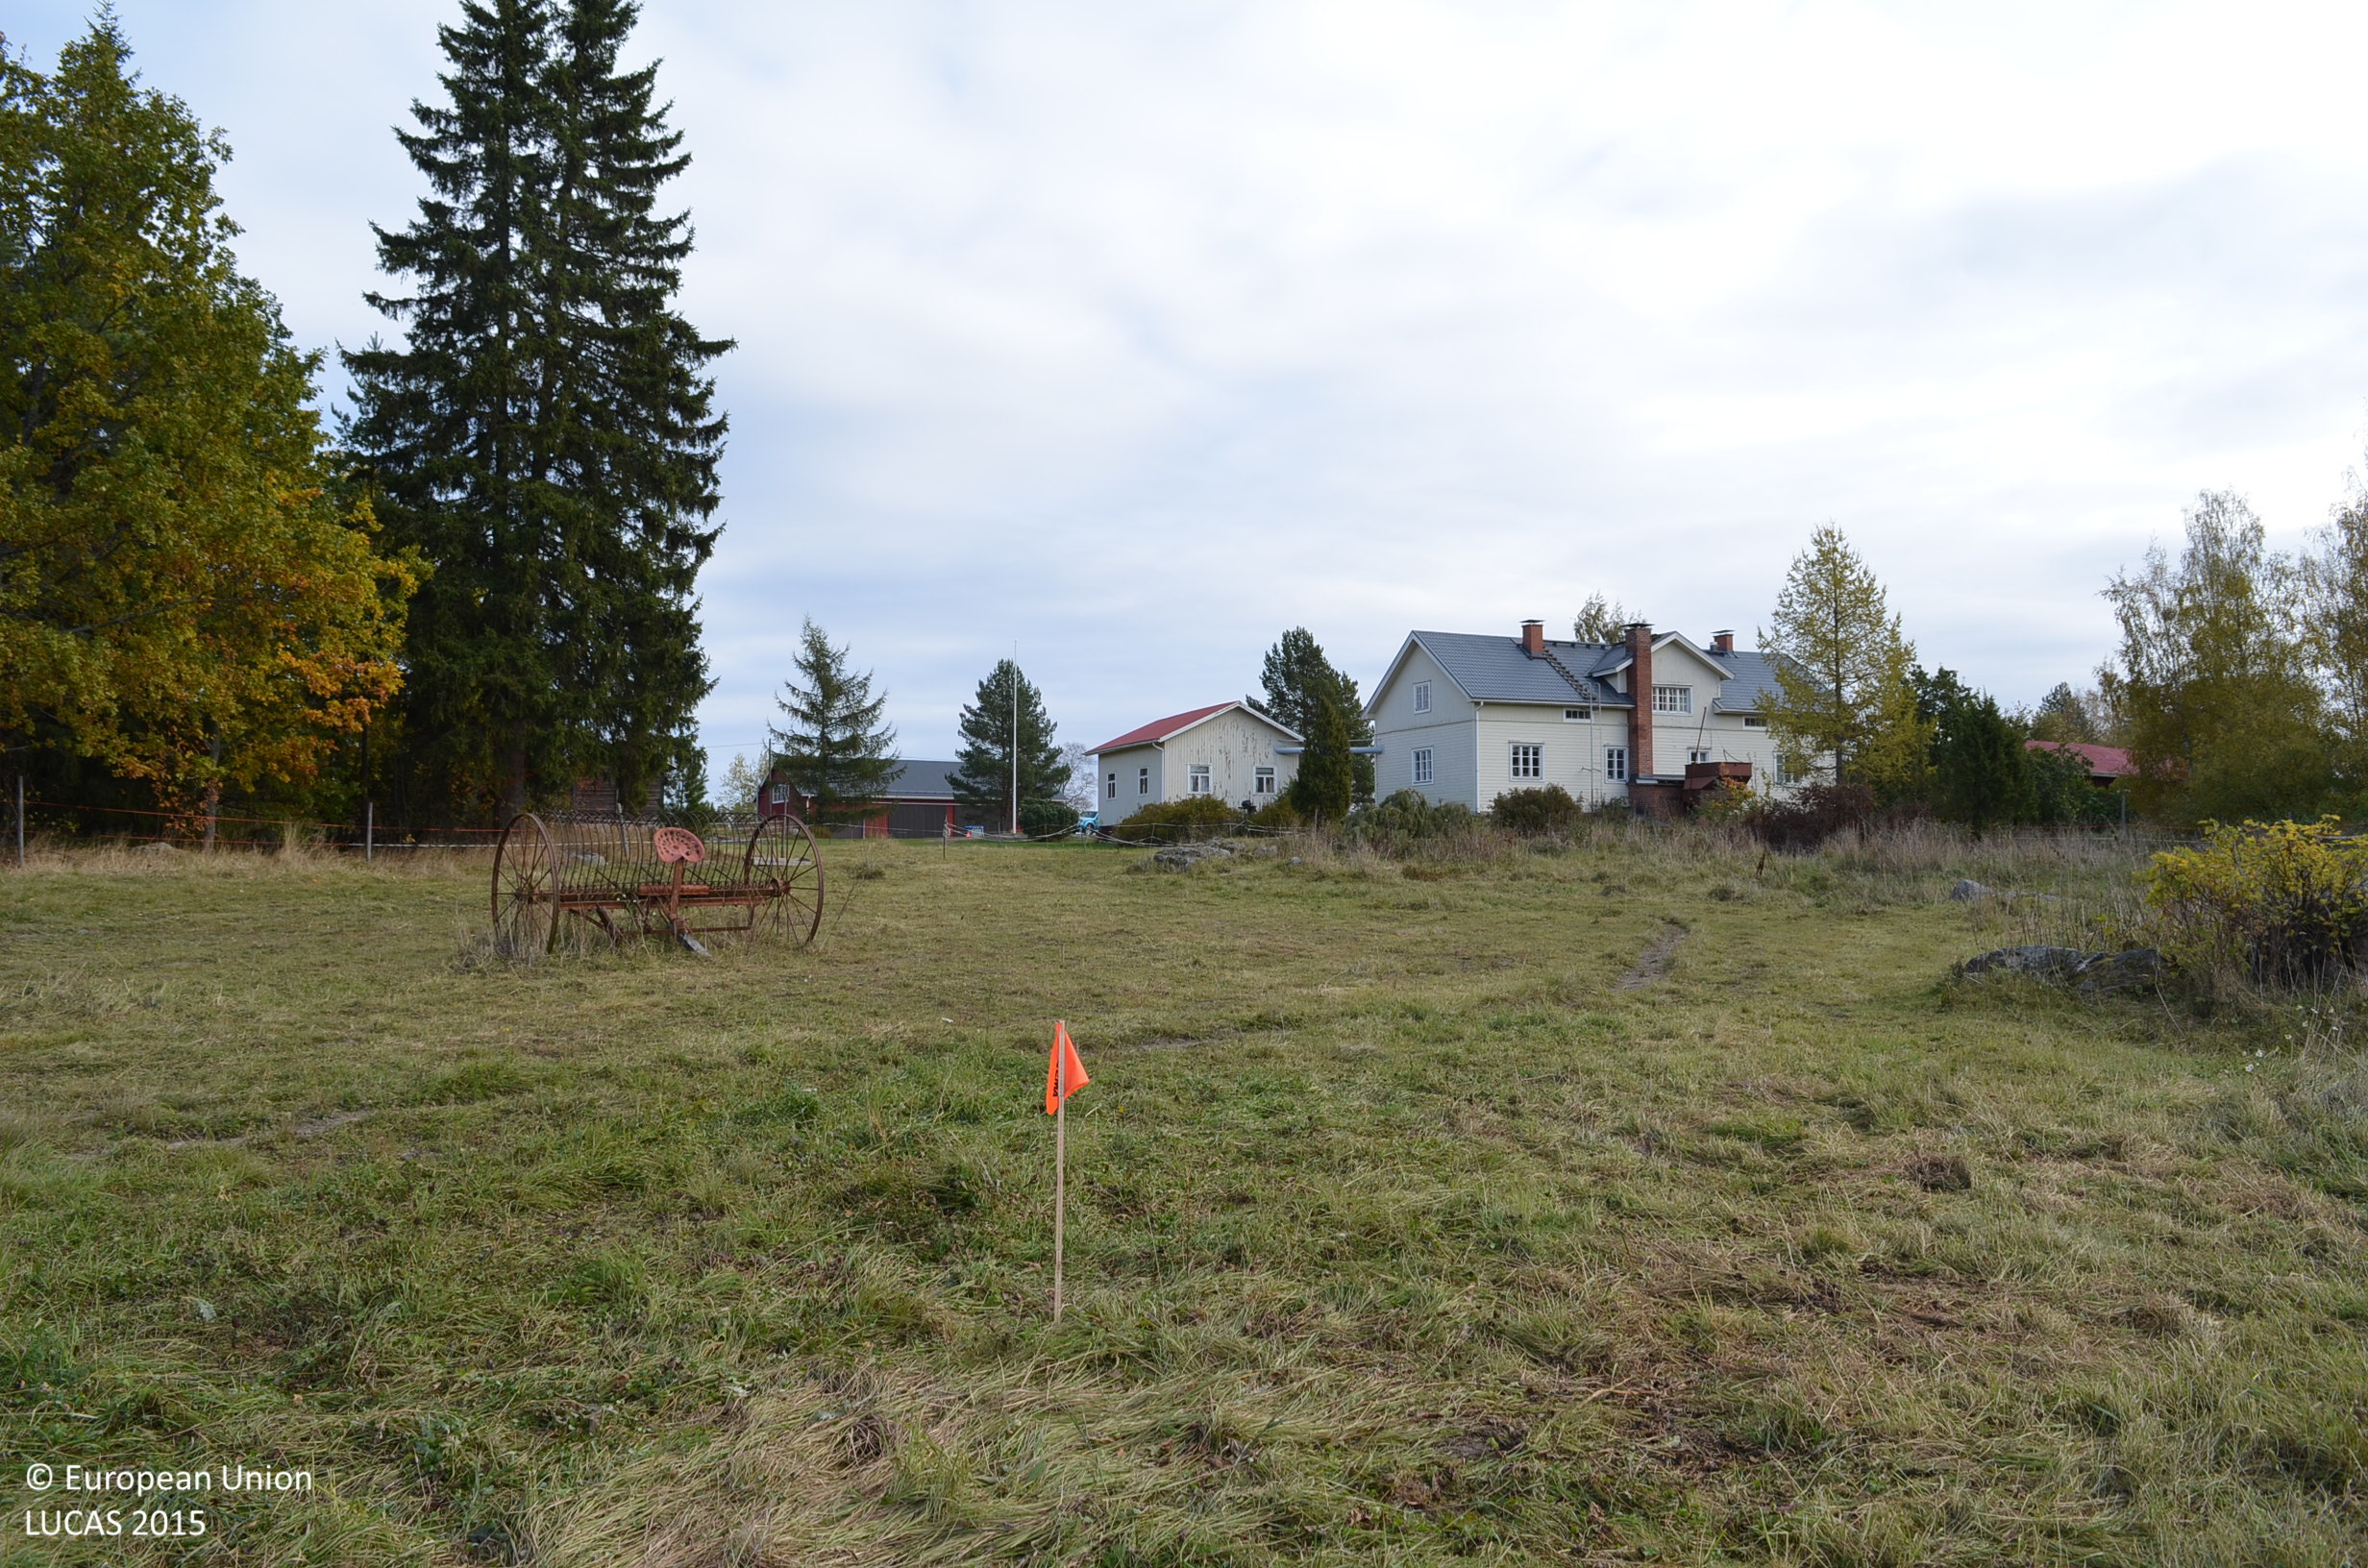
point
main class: Grassland
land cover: Grassland with sparse tree/shrub cover
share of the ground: > 75 %
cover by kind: herbaceous plants 80 %, unconsolidated bare surface 10 %, coniferous forest trees 5 %, shrubs 5 %
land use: Fallow land
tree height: > 5 m
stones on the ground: < 10 %
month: October
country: FI
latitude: 61.6597
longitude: 23.8121
